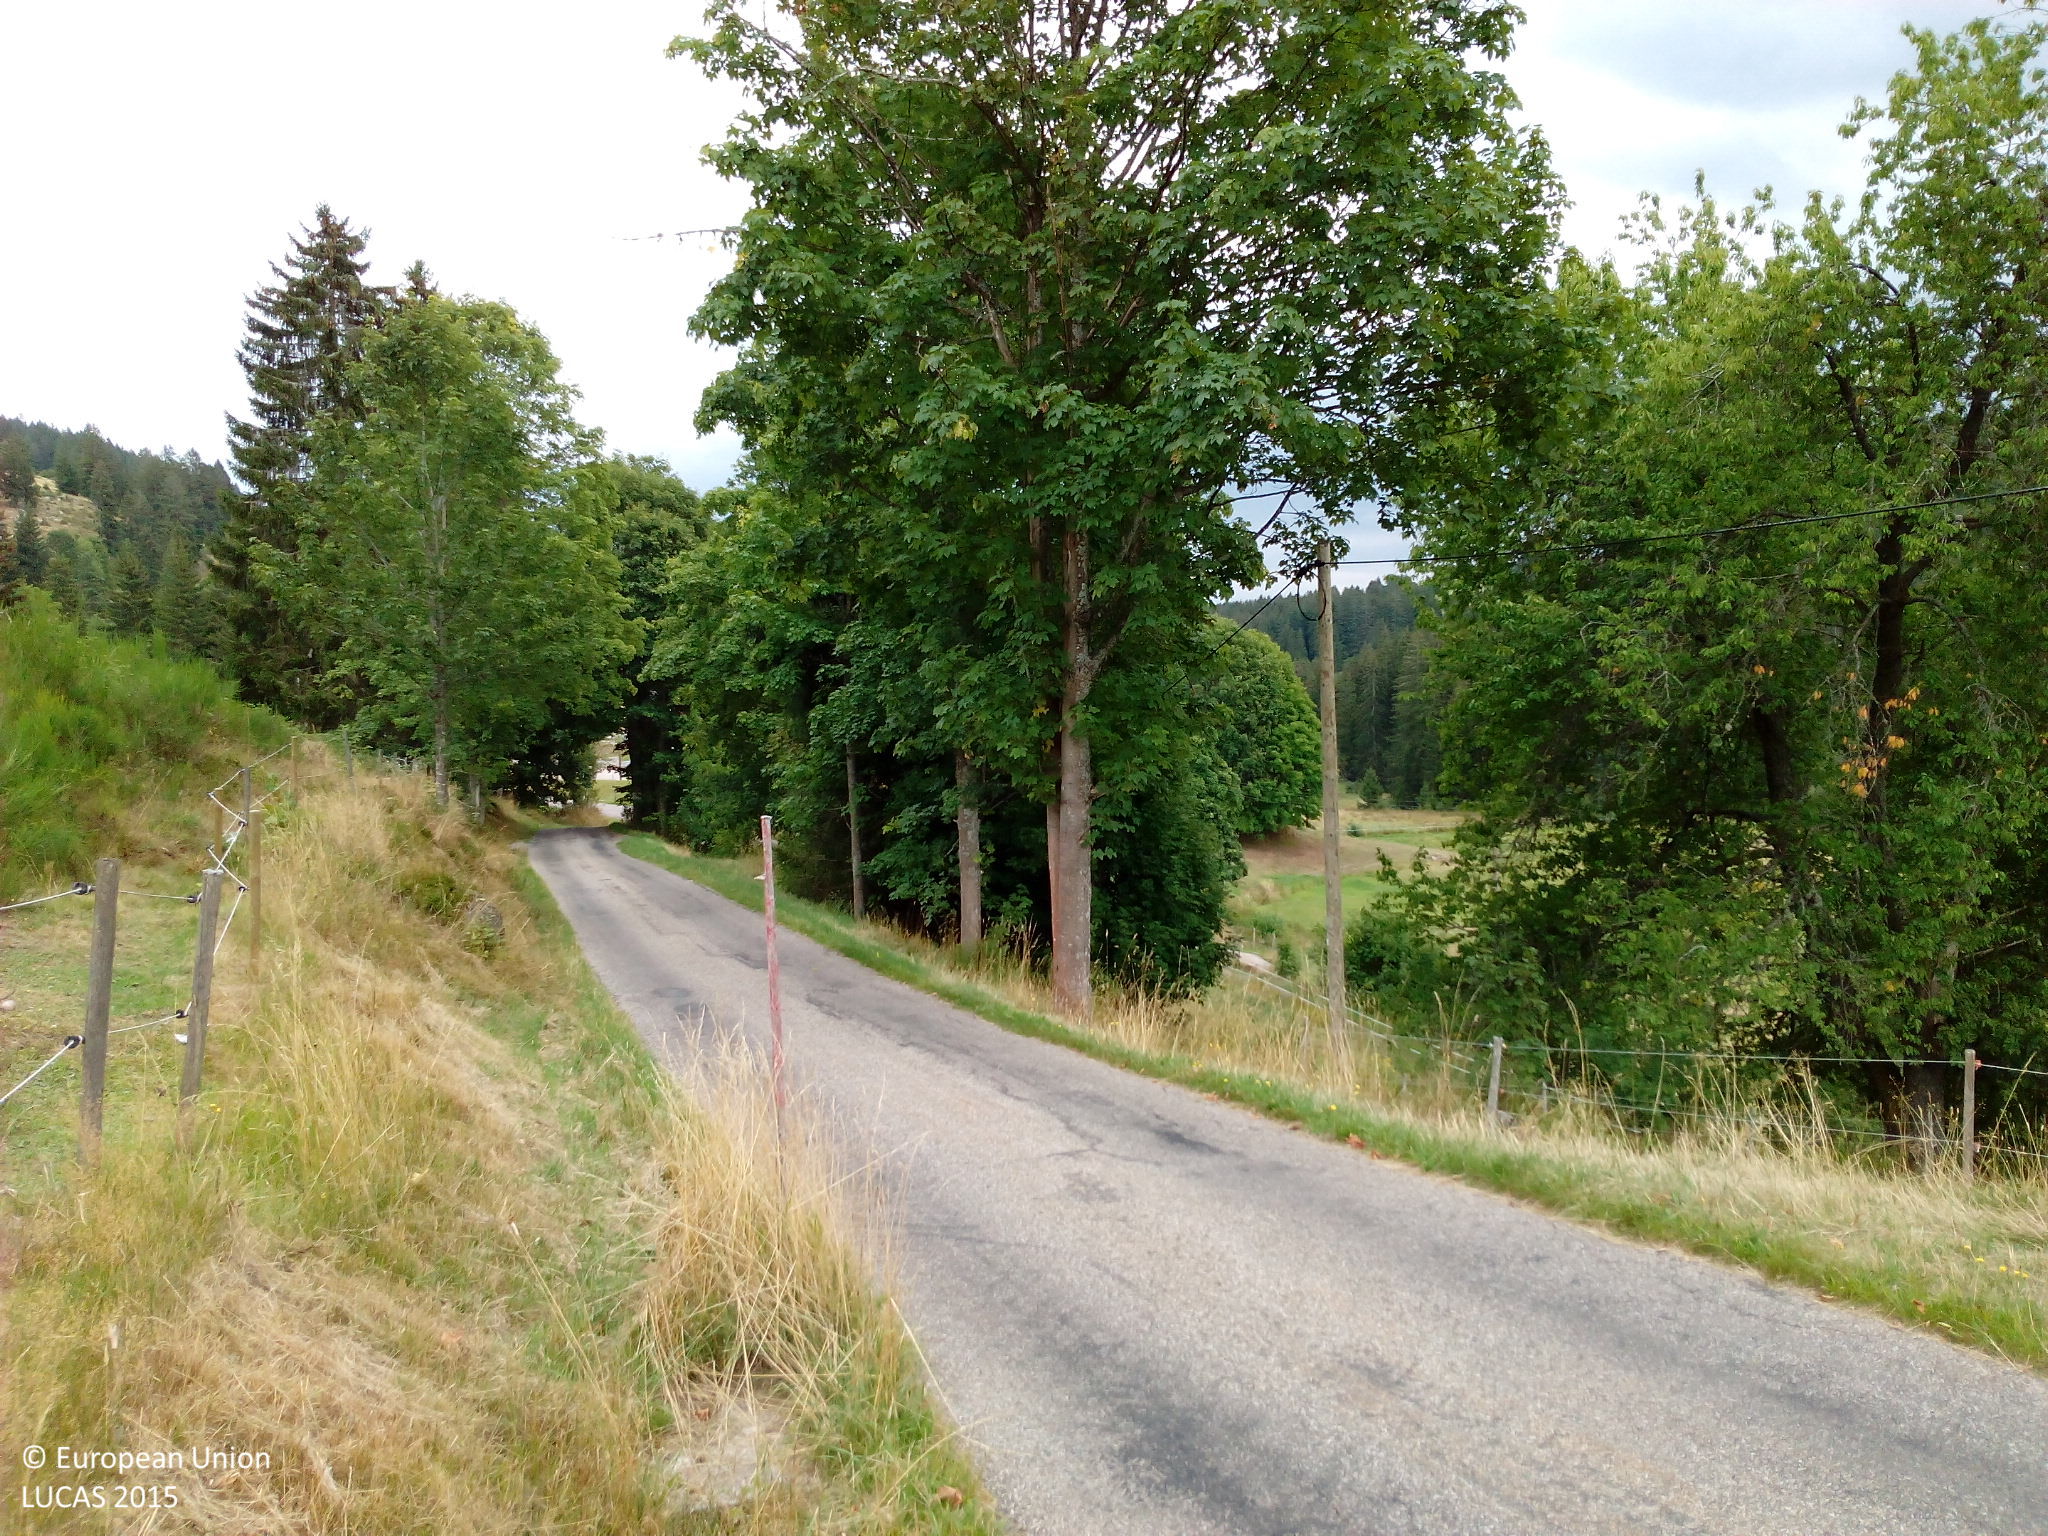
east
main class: Shrubland
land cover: Shrubland without tree cover
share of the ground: 25 - 50 %
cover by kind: herbaceous plants 75 %, shrubs 25 %
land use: Agriculture (excluding fallow land and kitchen gardens)
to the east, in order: Shrubland without tree cover; Fences; Grass margins; Paved roads, cycling and walking lanes; Broadleaved woodland; Electric lines; Broadleaved woodland; Fences; Grassland without tree/shrub cover; Artificial constructions in urban areas; Grassland without tree/shrub cover
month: August
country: DE
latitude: 47.7939
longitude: 8.1456
